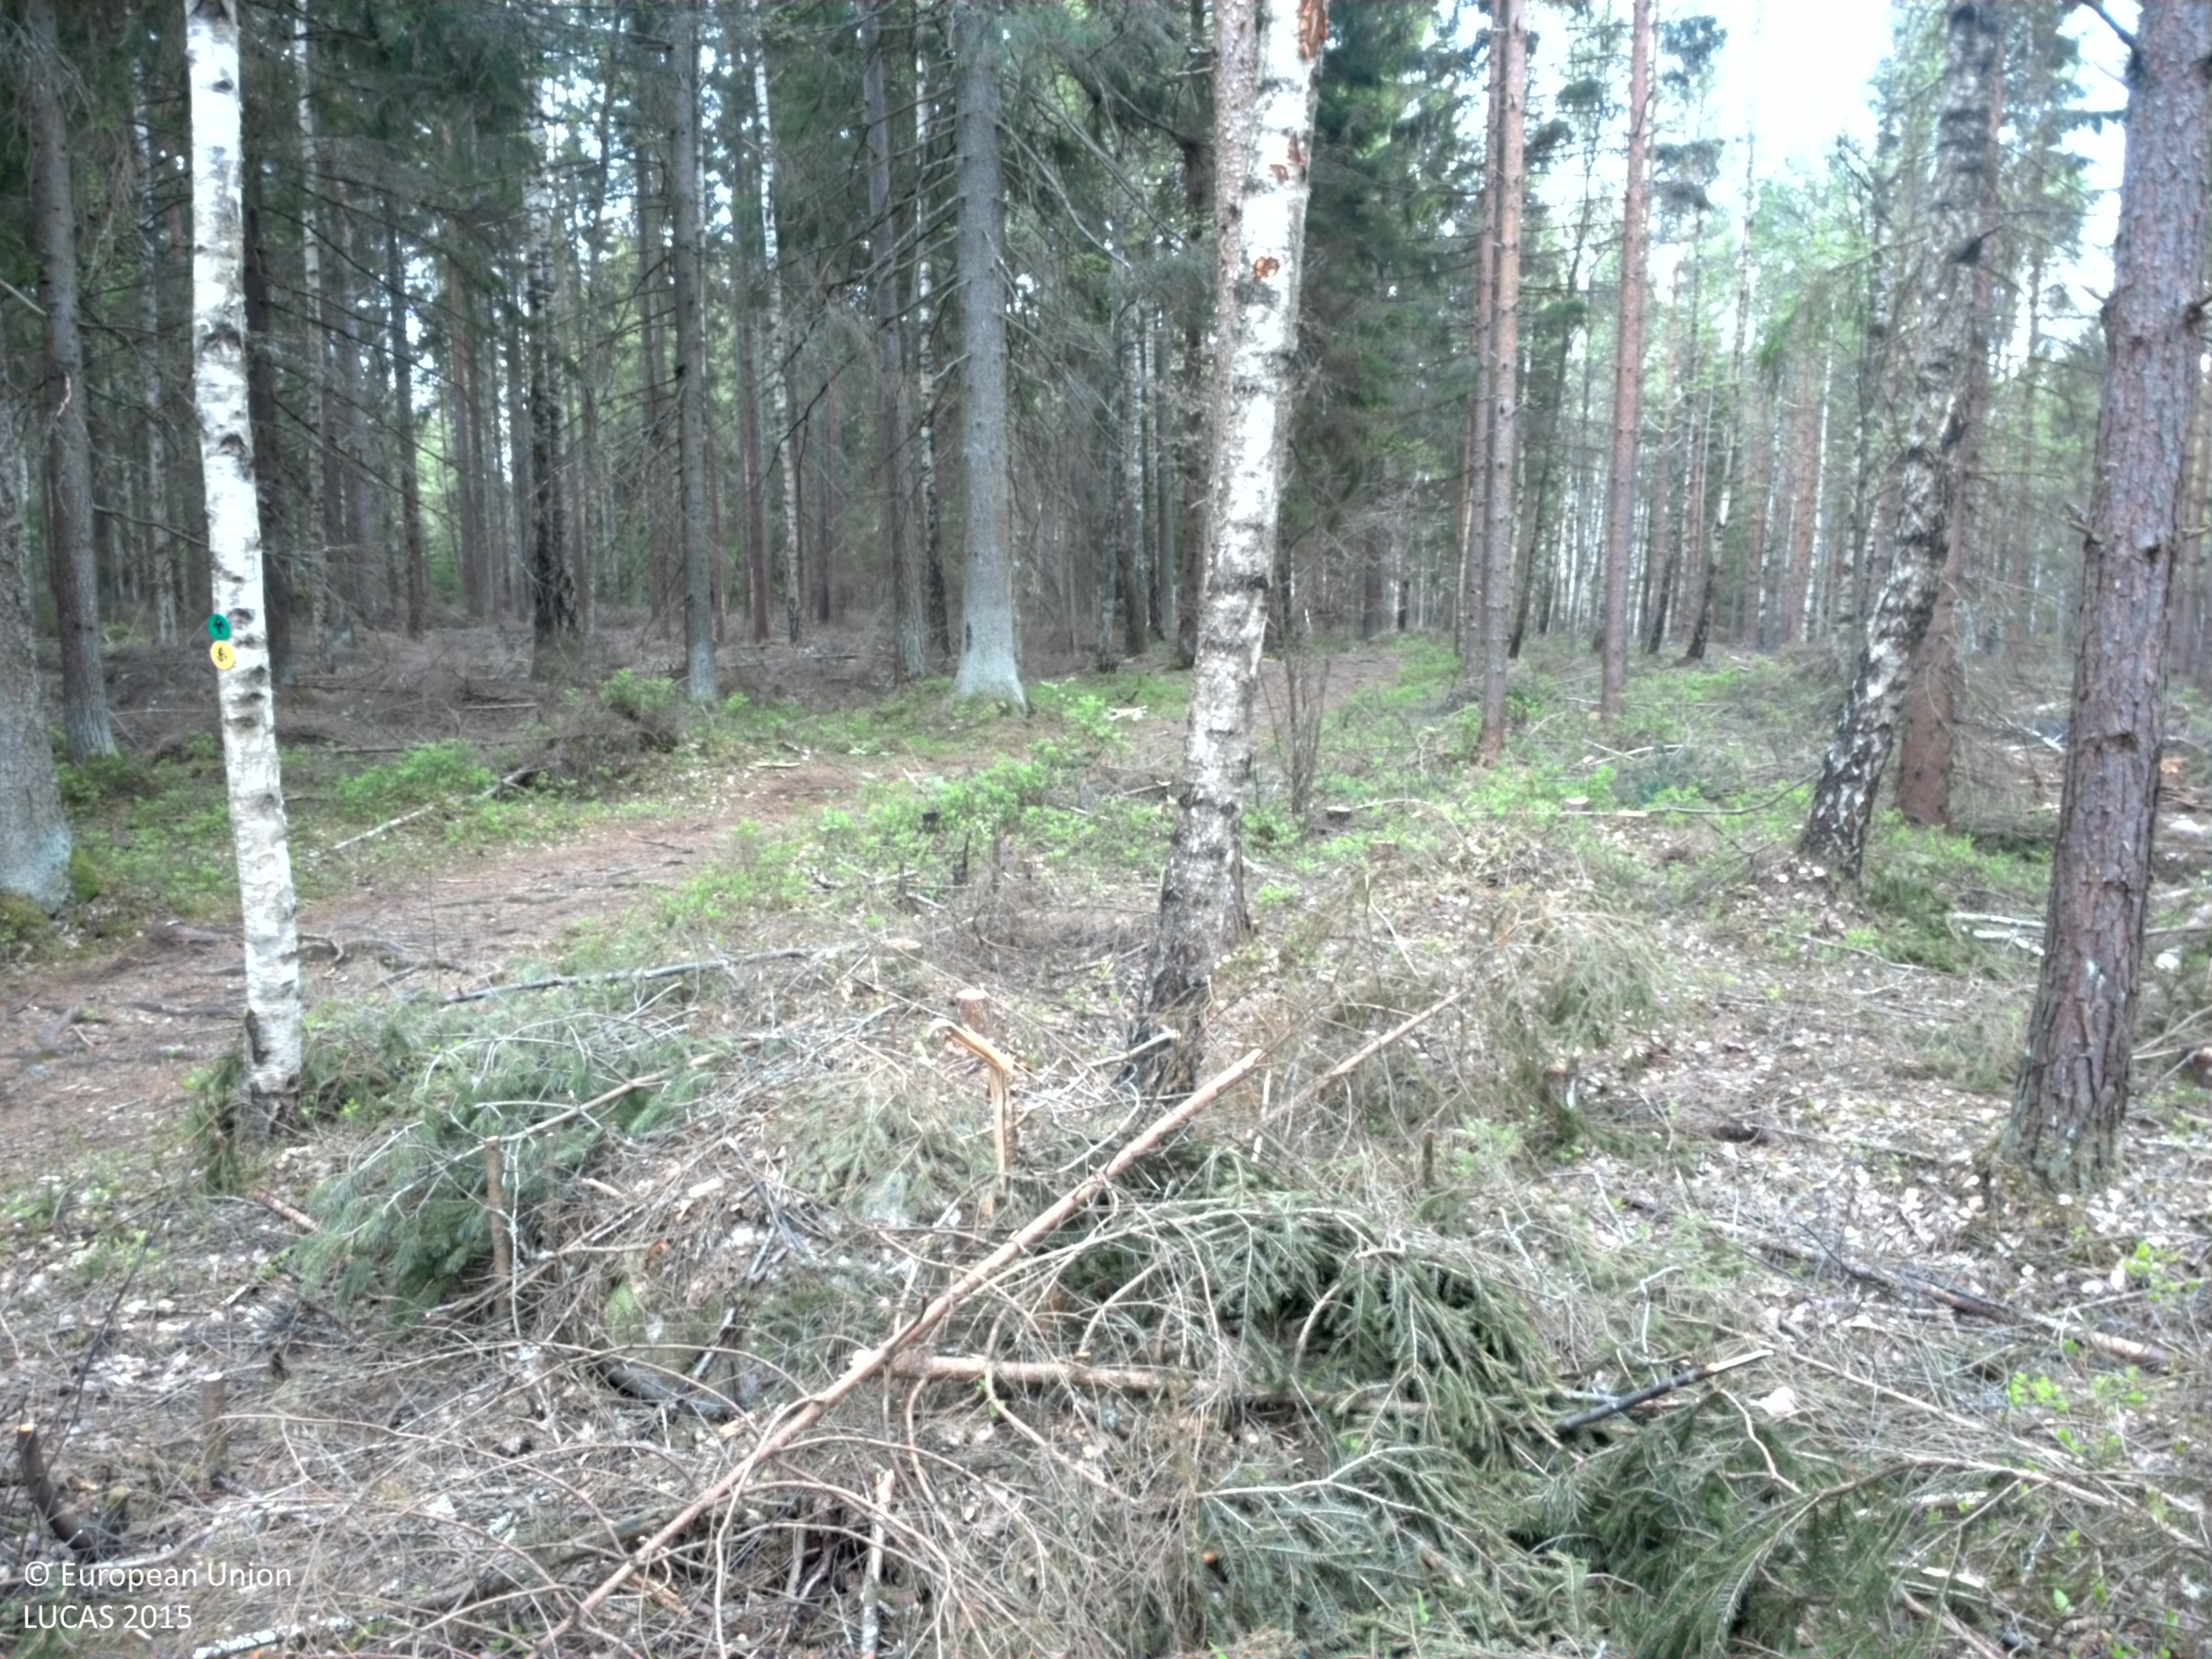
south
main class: Woodland
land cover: Other mixed woodland
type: boreal forest
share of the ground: > 75 %
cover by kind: coniferous forest trees 50 %, broadleaved forest trees 30 %, herbaceous plants 15 %, shrubs 5 %
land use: Forestry
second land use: Amenities, museums, leisure
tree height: > 5 m
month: May
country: SE
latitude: 59.2925
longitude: 14.0824
